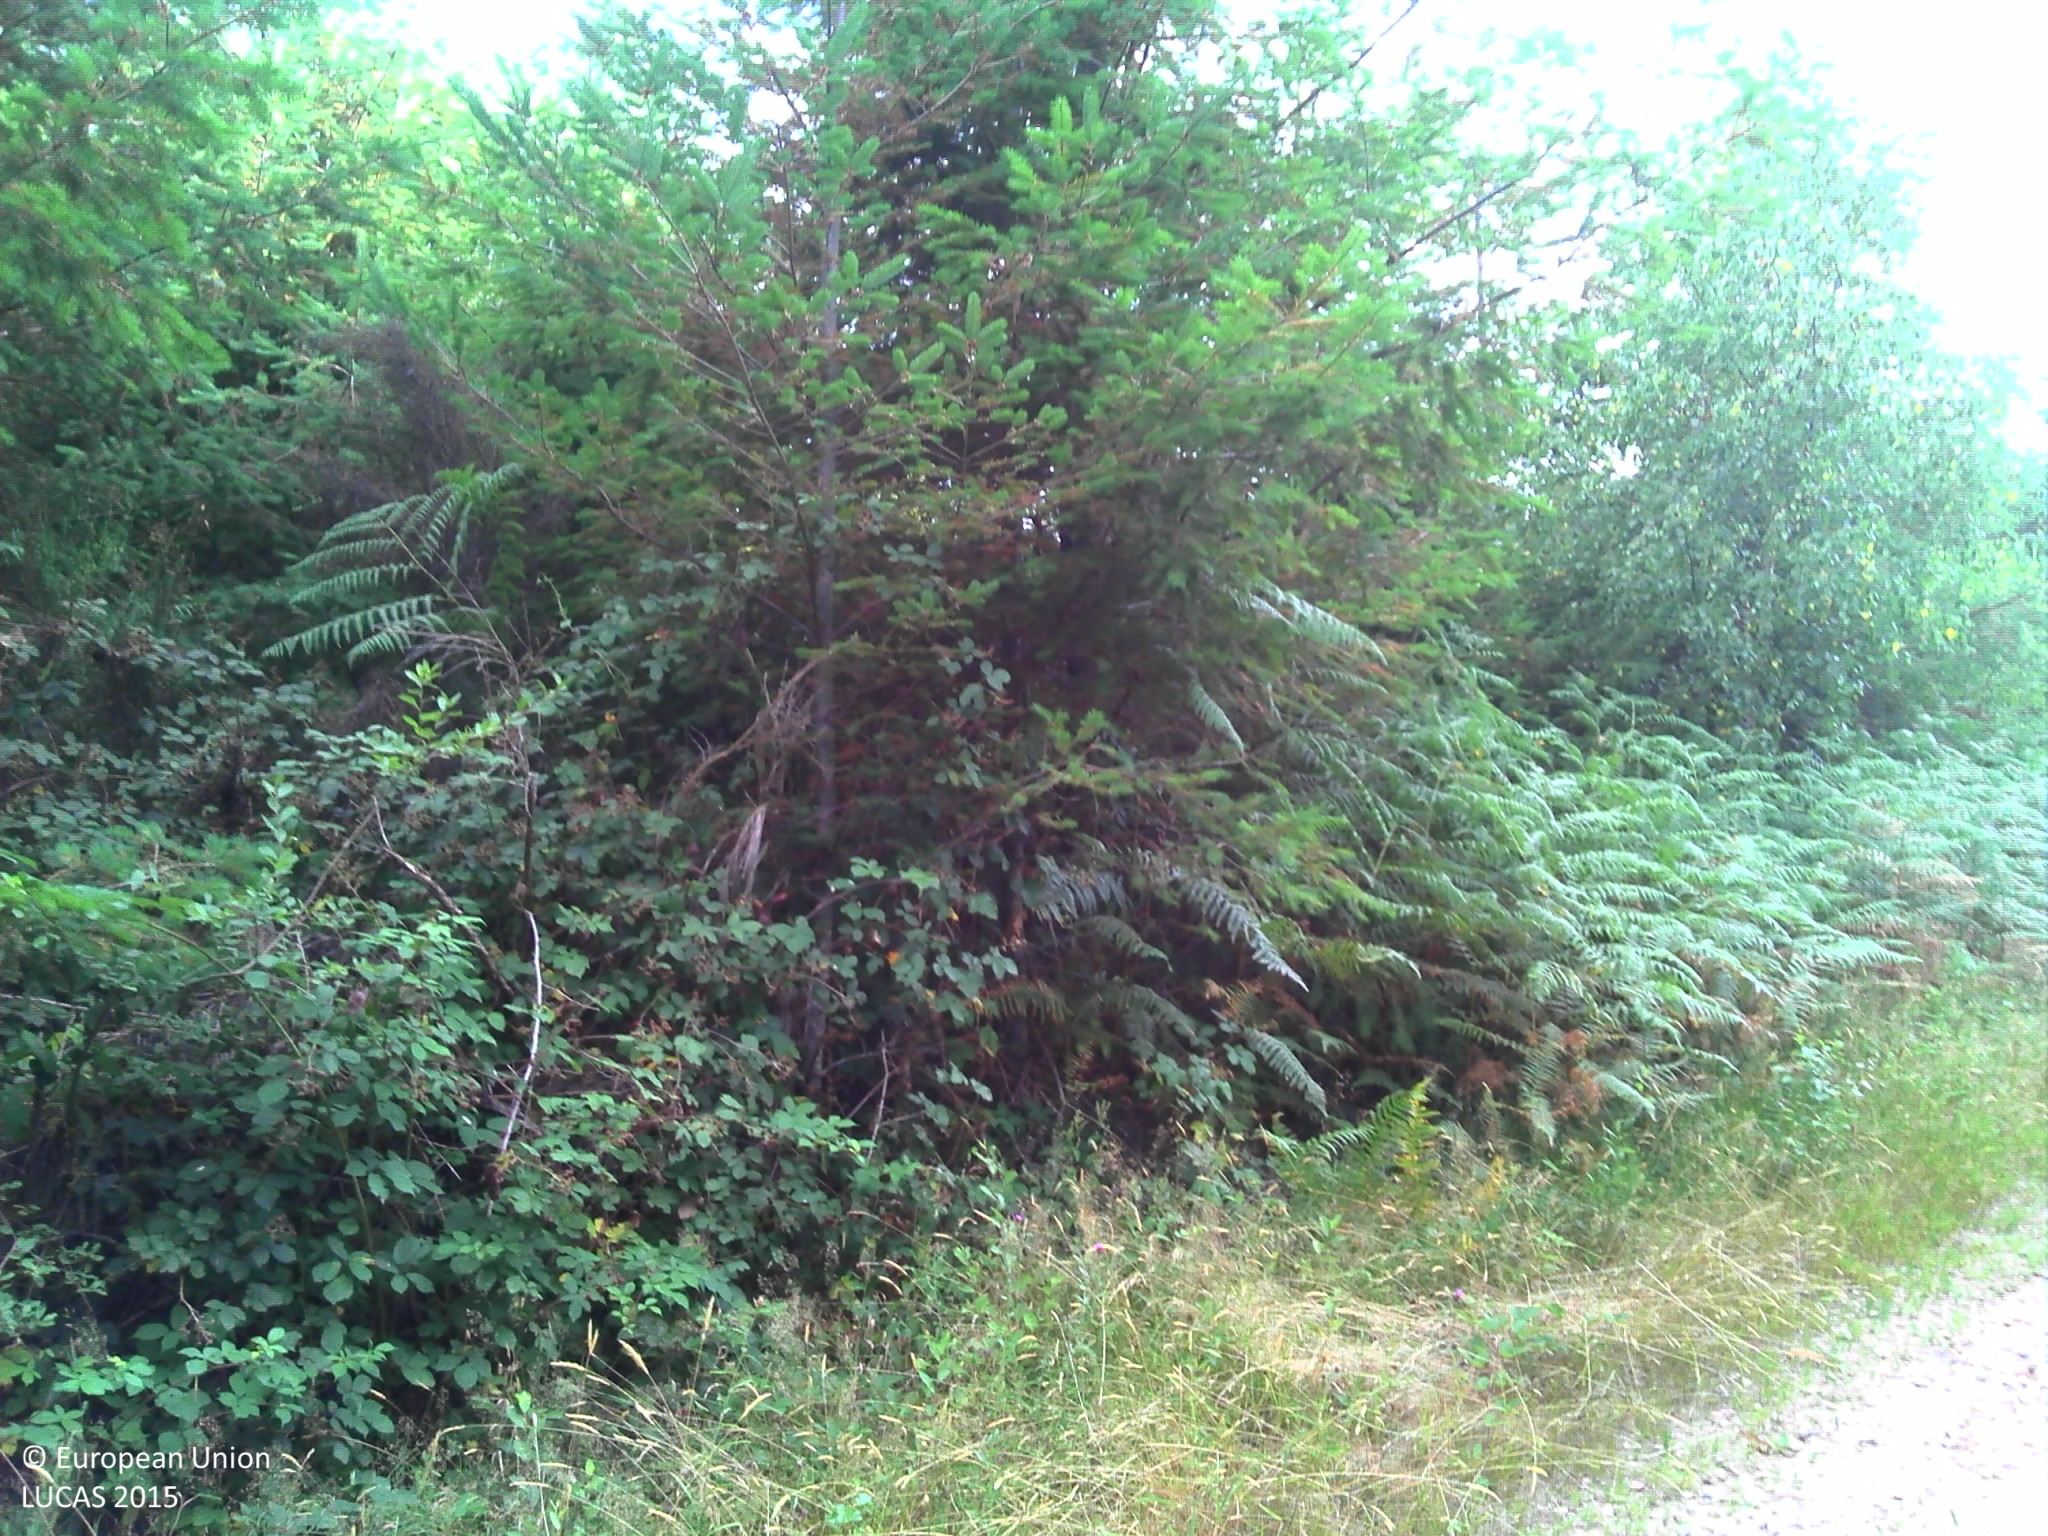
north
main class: Woodland
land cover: Spruce dominated mixed woodland
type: mesophytic deciduous forest
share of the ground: > 75 %
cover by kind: broadleaved forest trees 30 %, herbaceous plants 30 %, coniferous forest trees 20 %, lichens and mosses 20 %
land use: Forestry
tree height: > 5 m
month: July
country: FR
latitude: 45.5596
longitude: 1.0613
